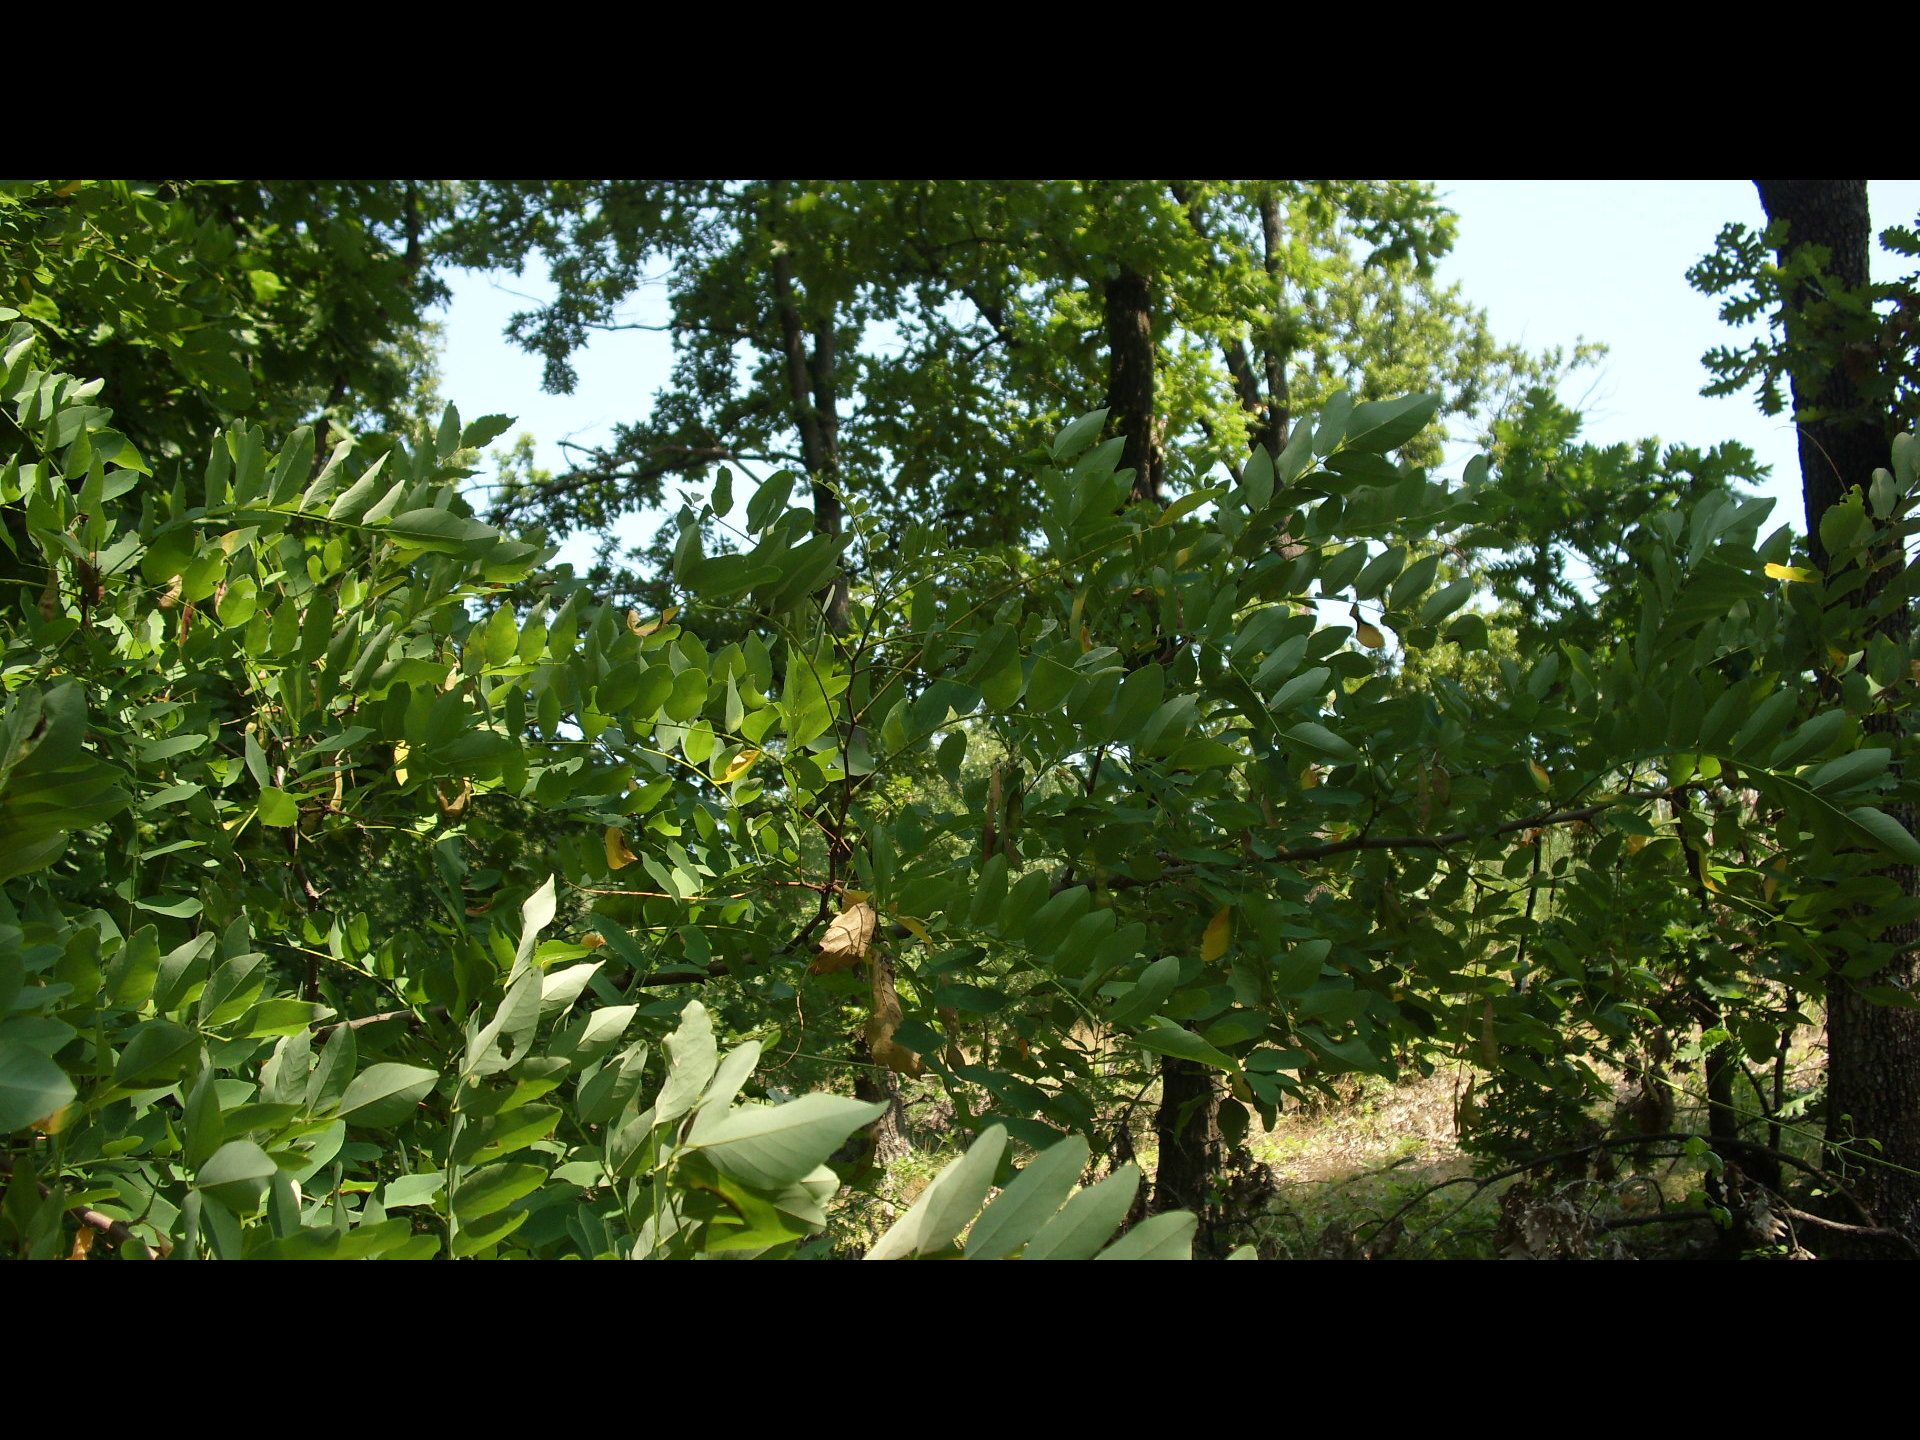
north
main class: Woodland
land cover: Broadleaved woodland
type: mesophytic deciduous forest
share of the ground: > 75 %
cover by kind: broadleaved forest trees 100 %
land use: Forestry
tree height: > 5 m
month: July
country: BG
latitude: 43.7950
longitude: 22.6242
